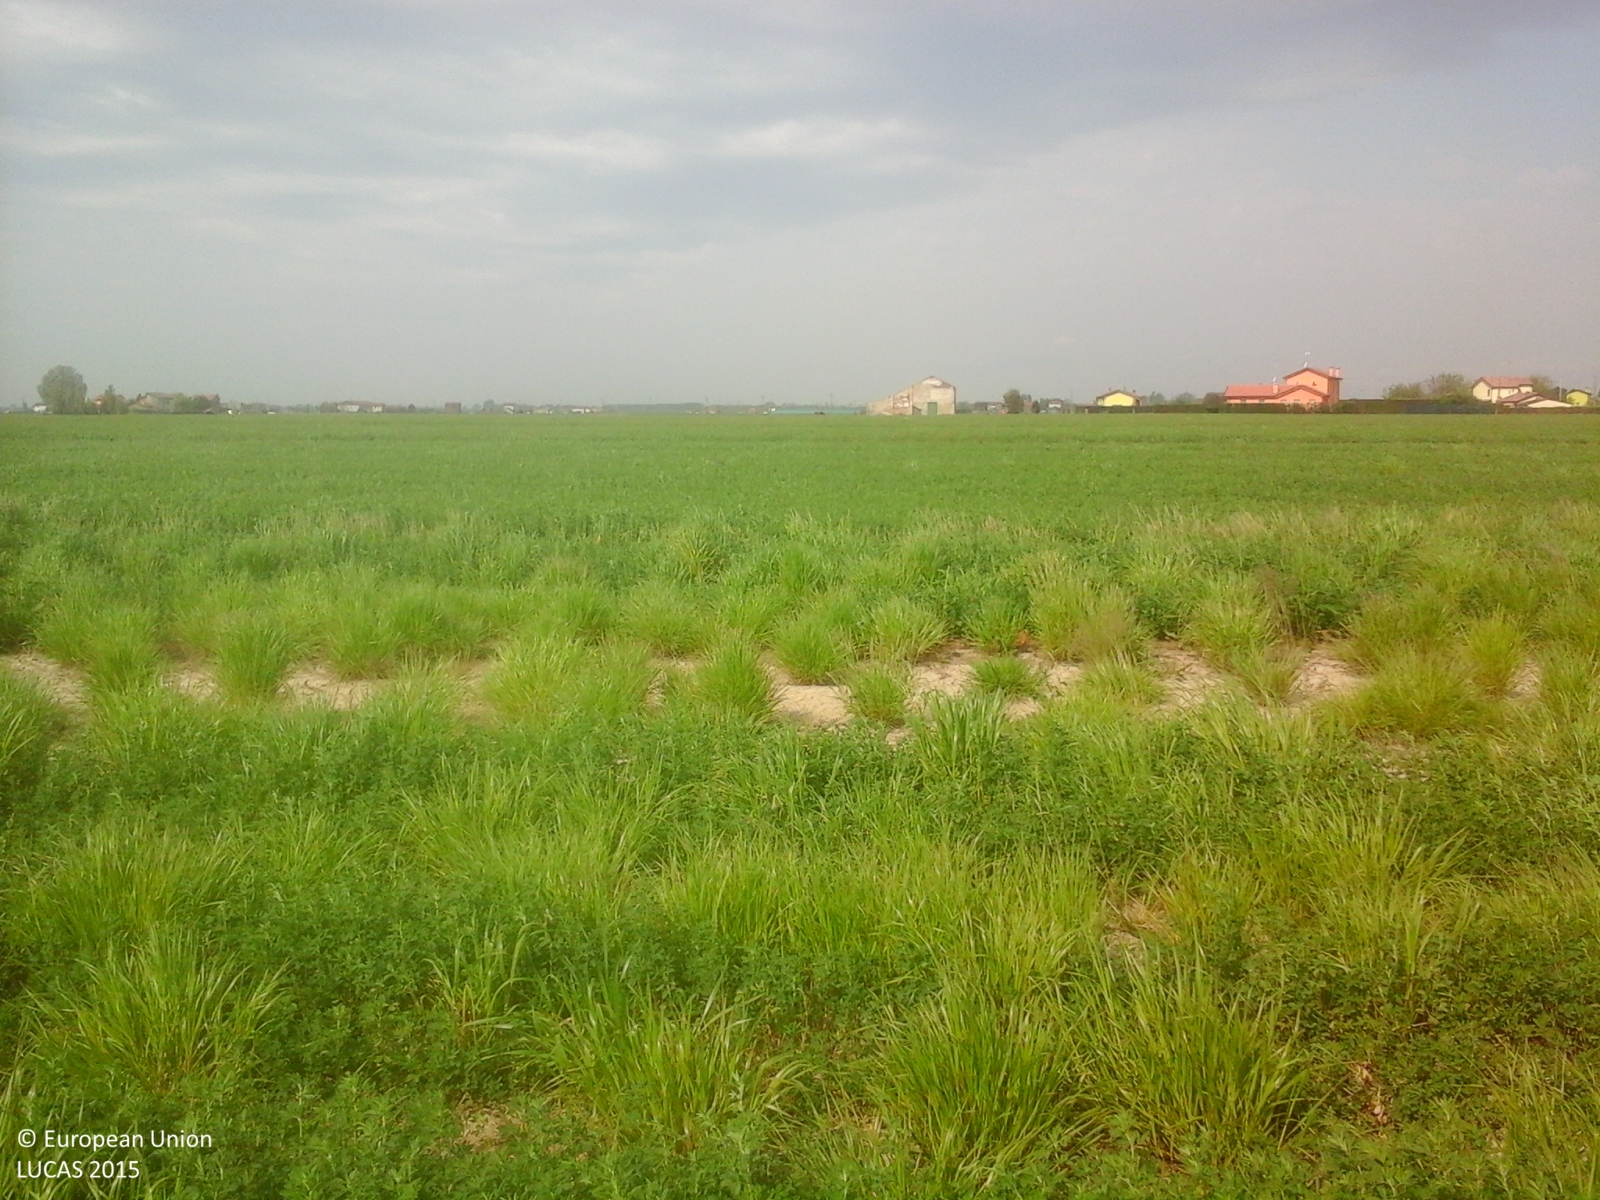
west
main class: Cropland
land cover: Lucerne
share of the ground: > 75 %
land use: Agriculture (excluding fallow land and kitchen gardens)
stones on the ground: < 10 %
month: April
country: IT
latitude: 44.9899
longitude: 12.4183
